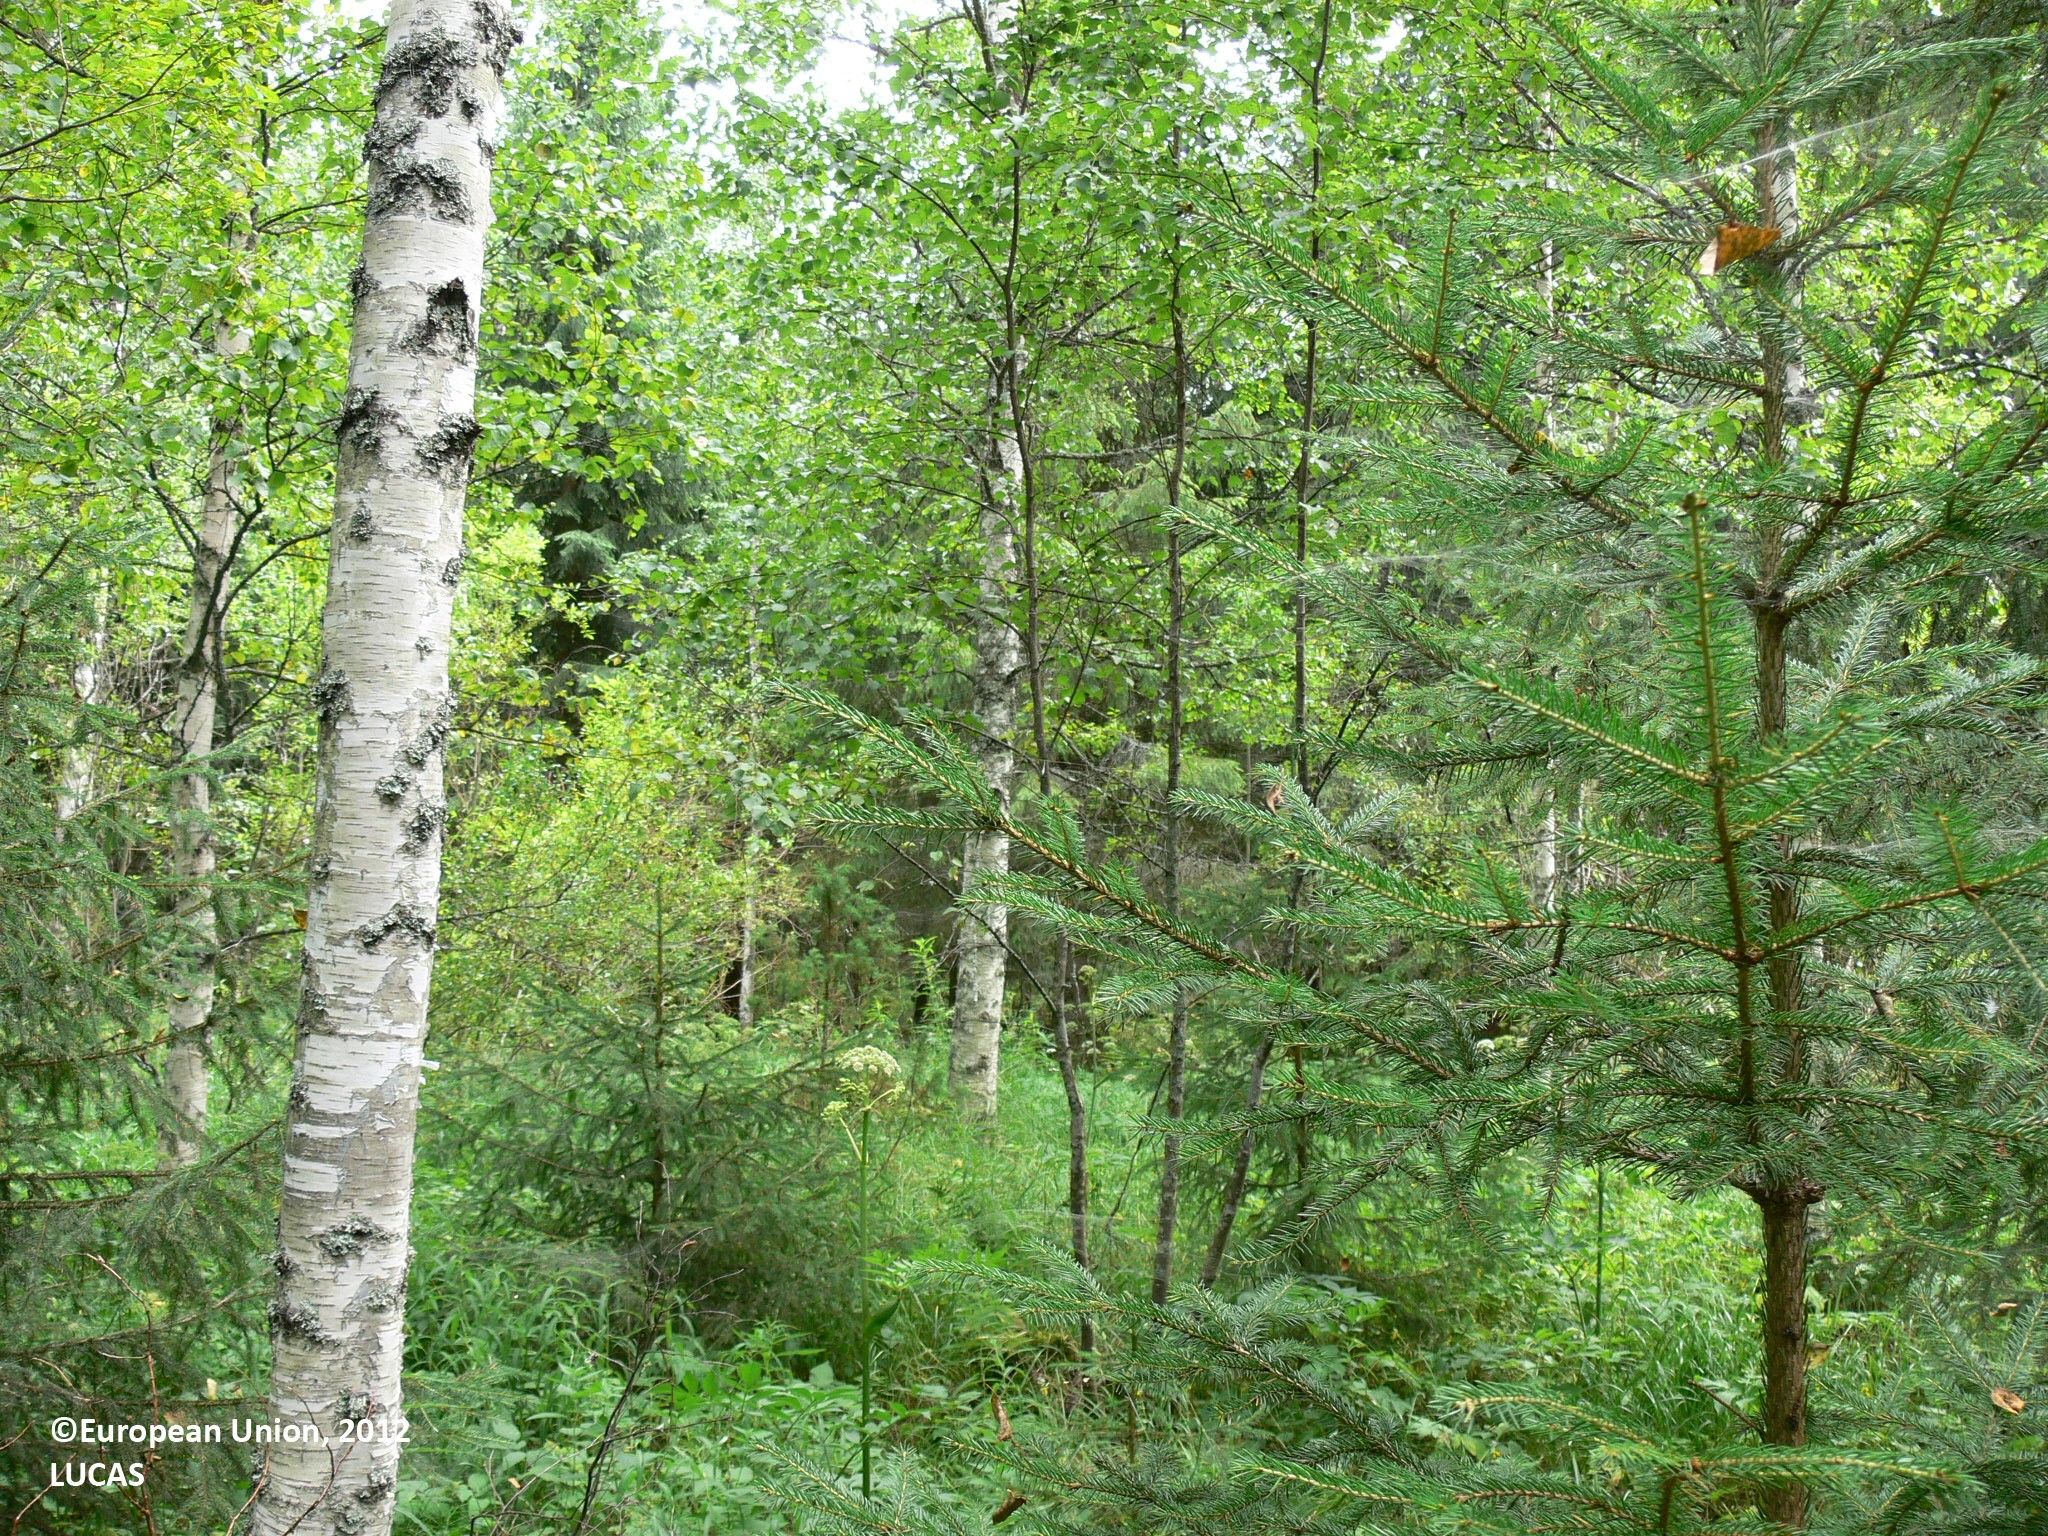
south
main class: Woodland
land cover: Spruce dominated mixed woodland
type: boreal forest
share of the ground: > 75 %
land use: Forestry
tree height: > 5 m
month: July
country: FI
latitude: 62.0260
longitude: 30.0469
